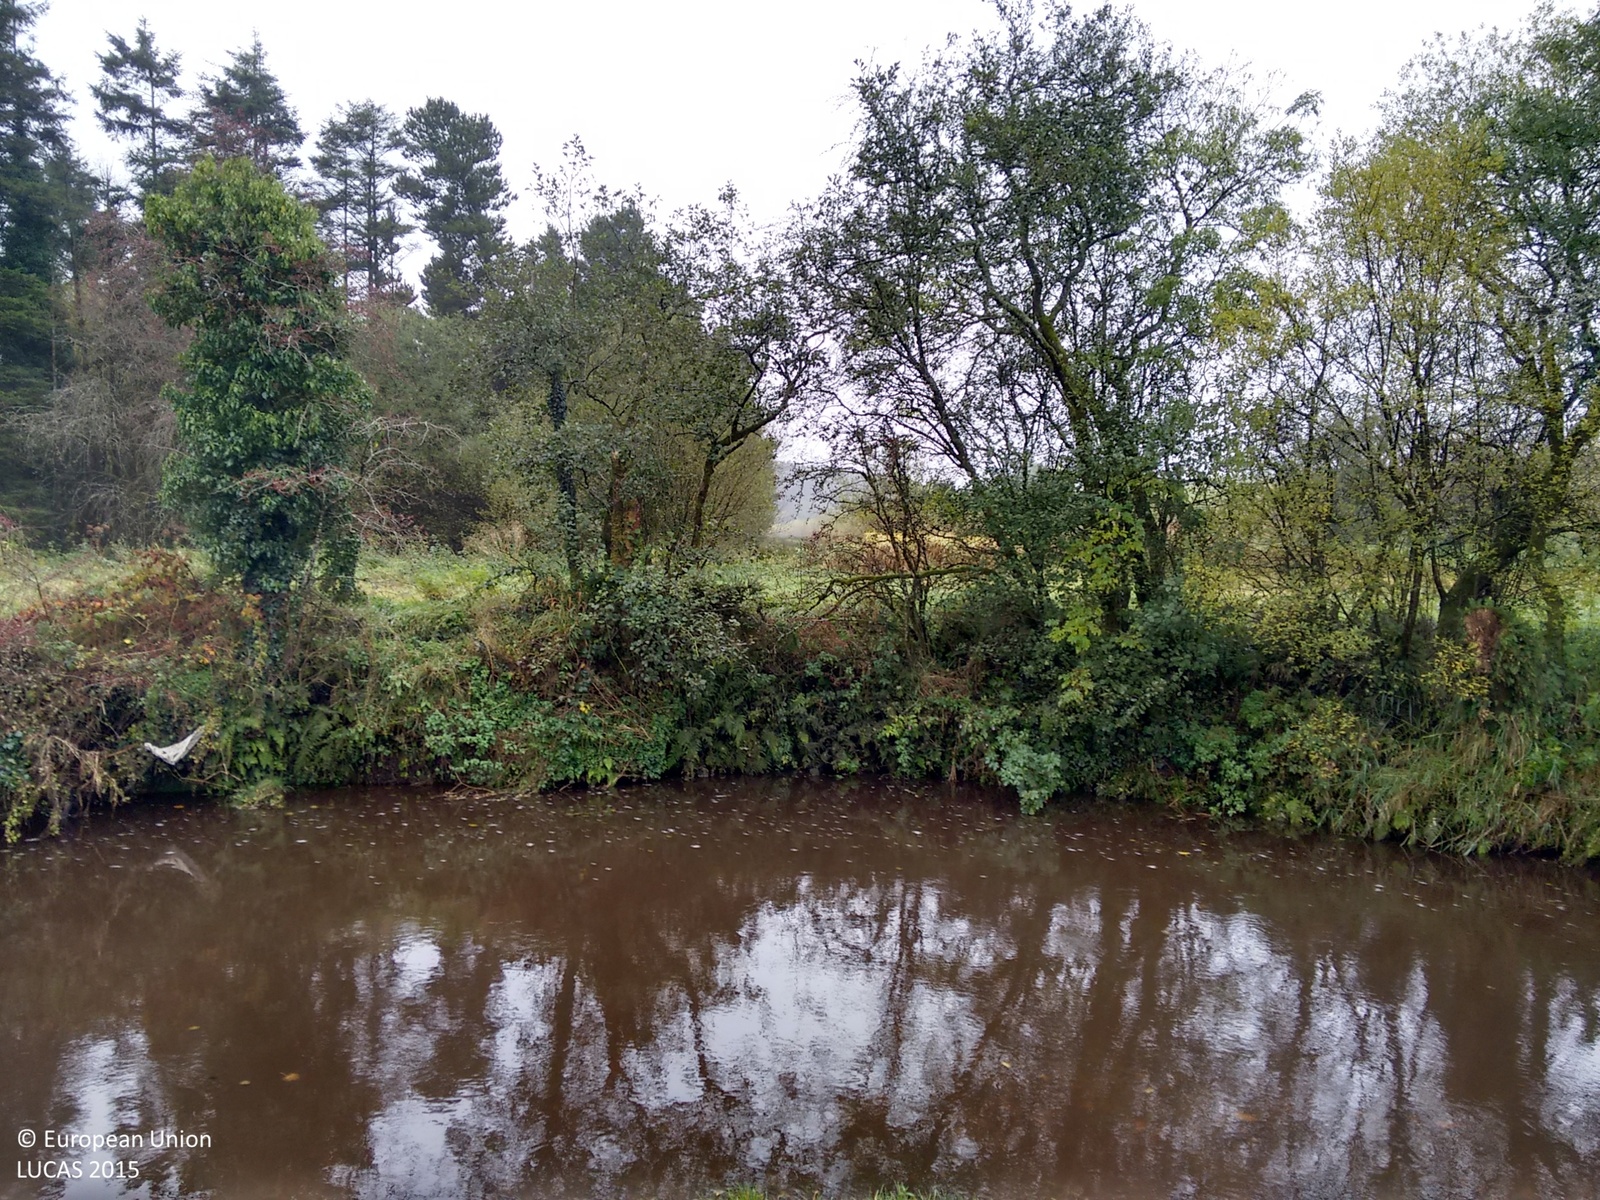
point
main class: Grassland
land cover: Grassland without tree/shrub cover
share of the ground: > 75 %
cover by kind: herbaceous plants 100 %
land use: Agriculture (excluding fallow land and kitchen gardens)
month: October
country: GB
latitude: 54.5351
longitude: -7.4477
